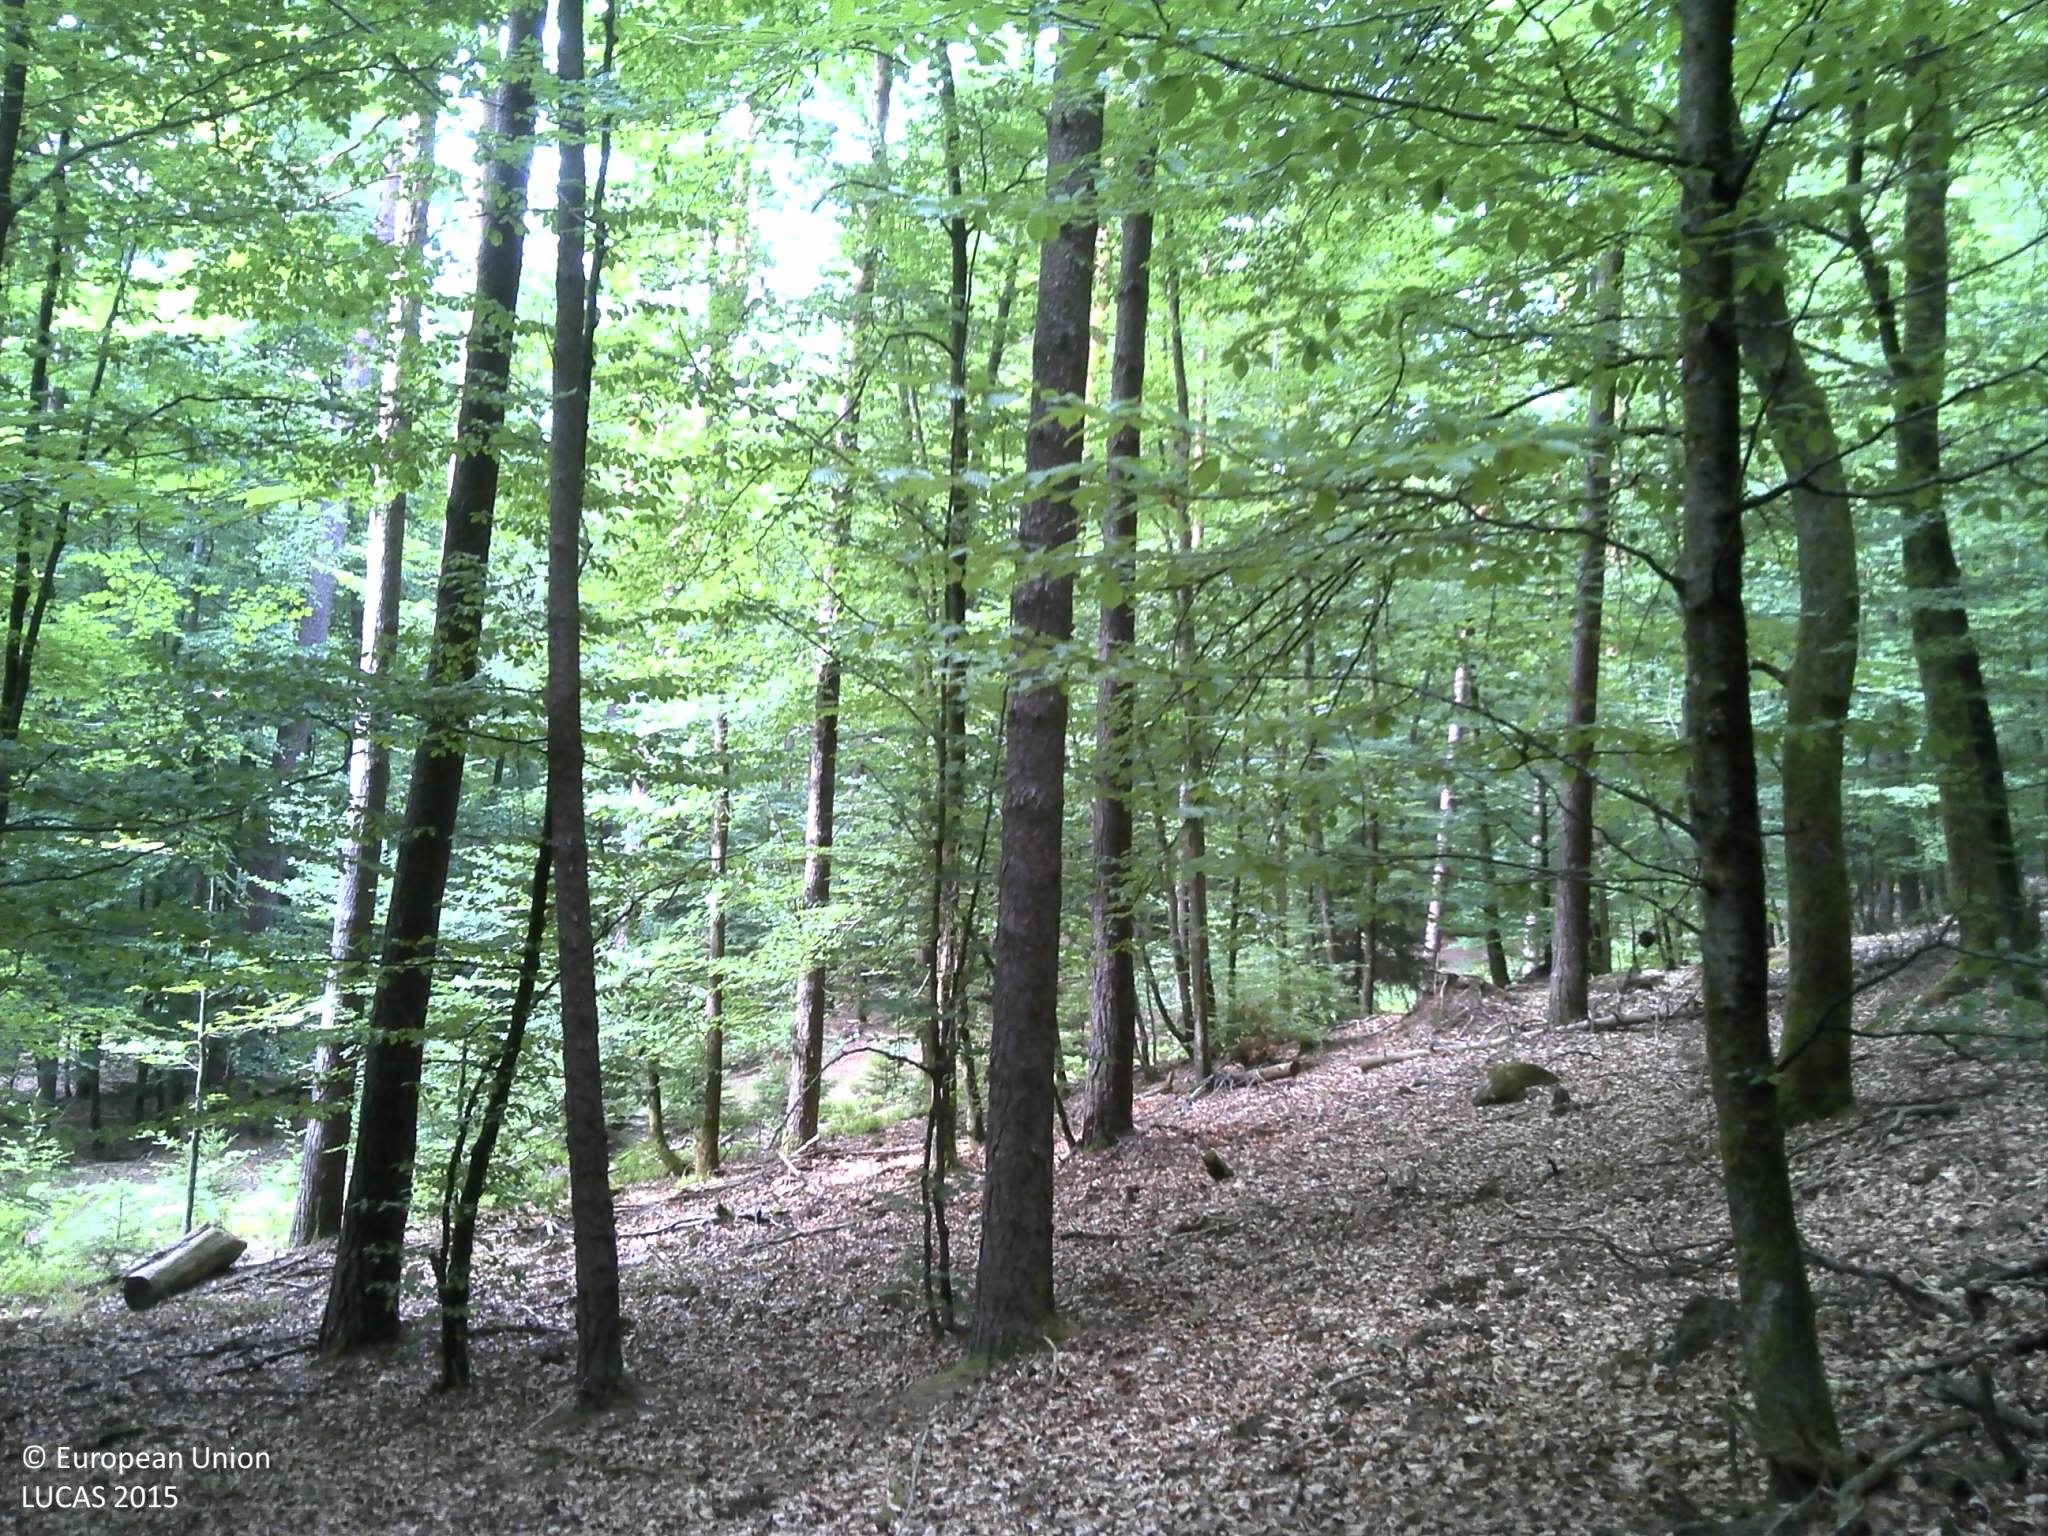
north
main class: Woodland
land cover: Pine dominated mixed woodland
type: hemiboreal forest and nemoral coniferous forest and mixed broadleaved-coniferous forest
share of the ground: > 75 %
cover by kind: broadleaved forest trees 60 %, coniferous forest trees 40 %
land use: Forestry
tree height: > 5 m
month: July
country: FR
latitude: 49.0226
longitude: 7.4707
